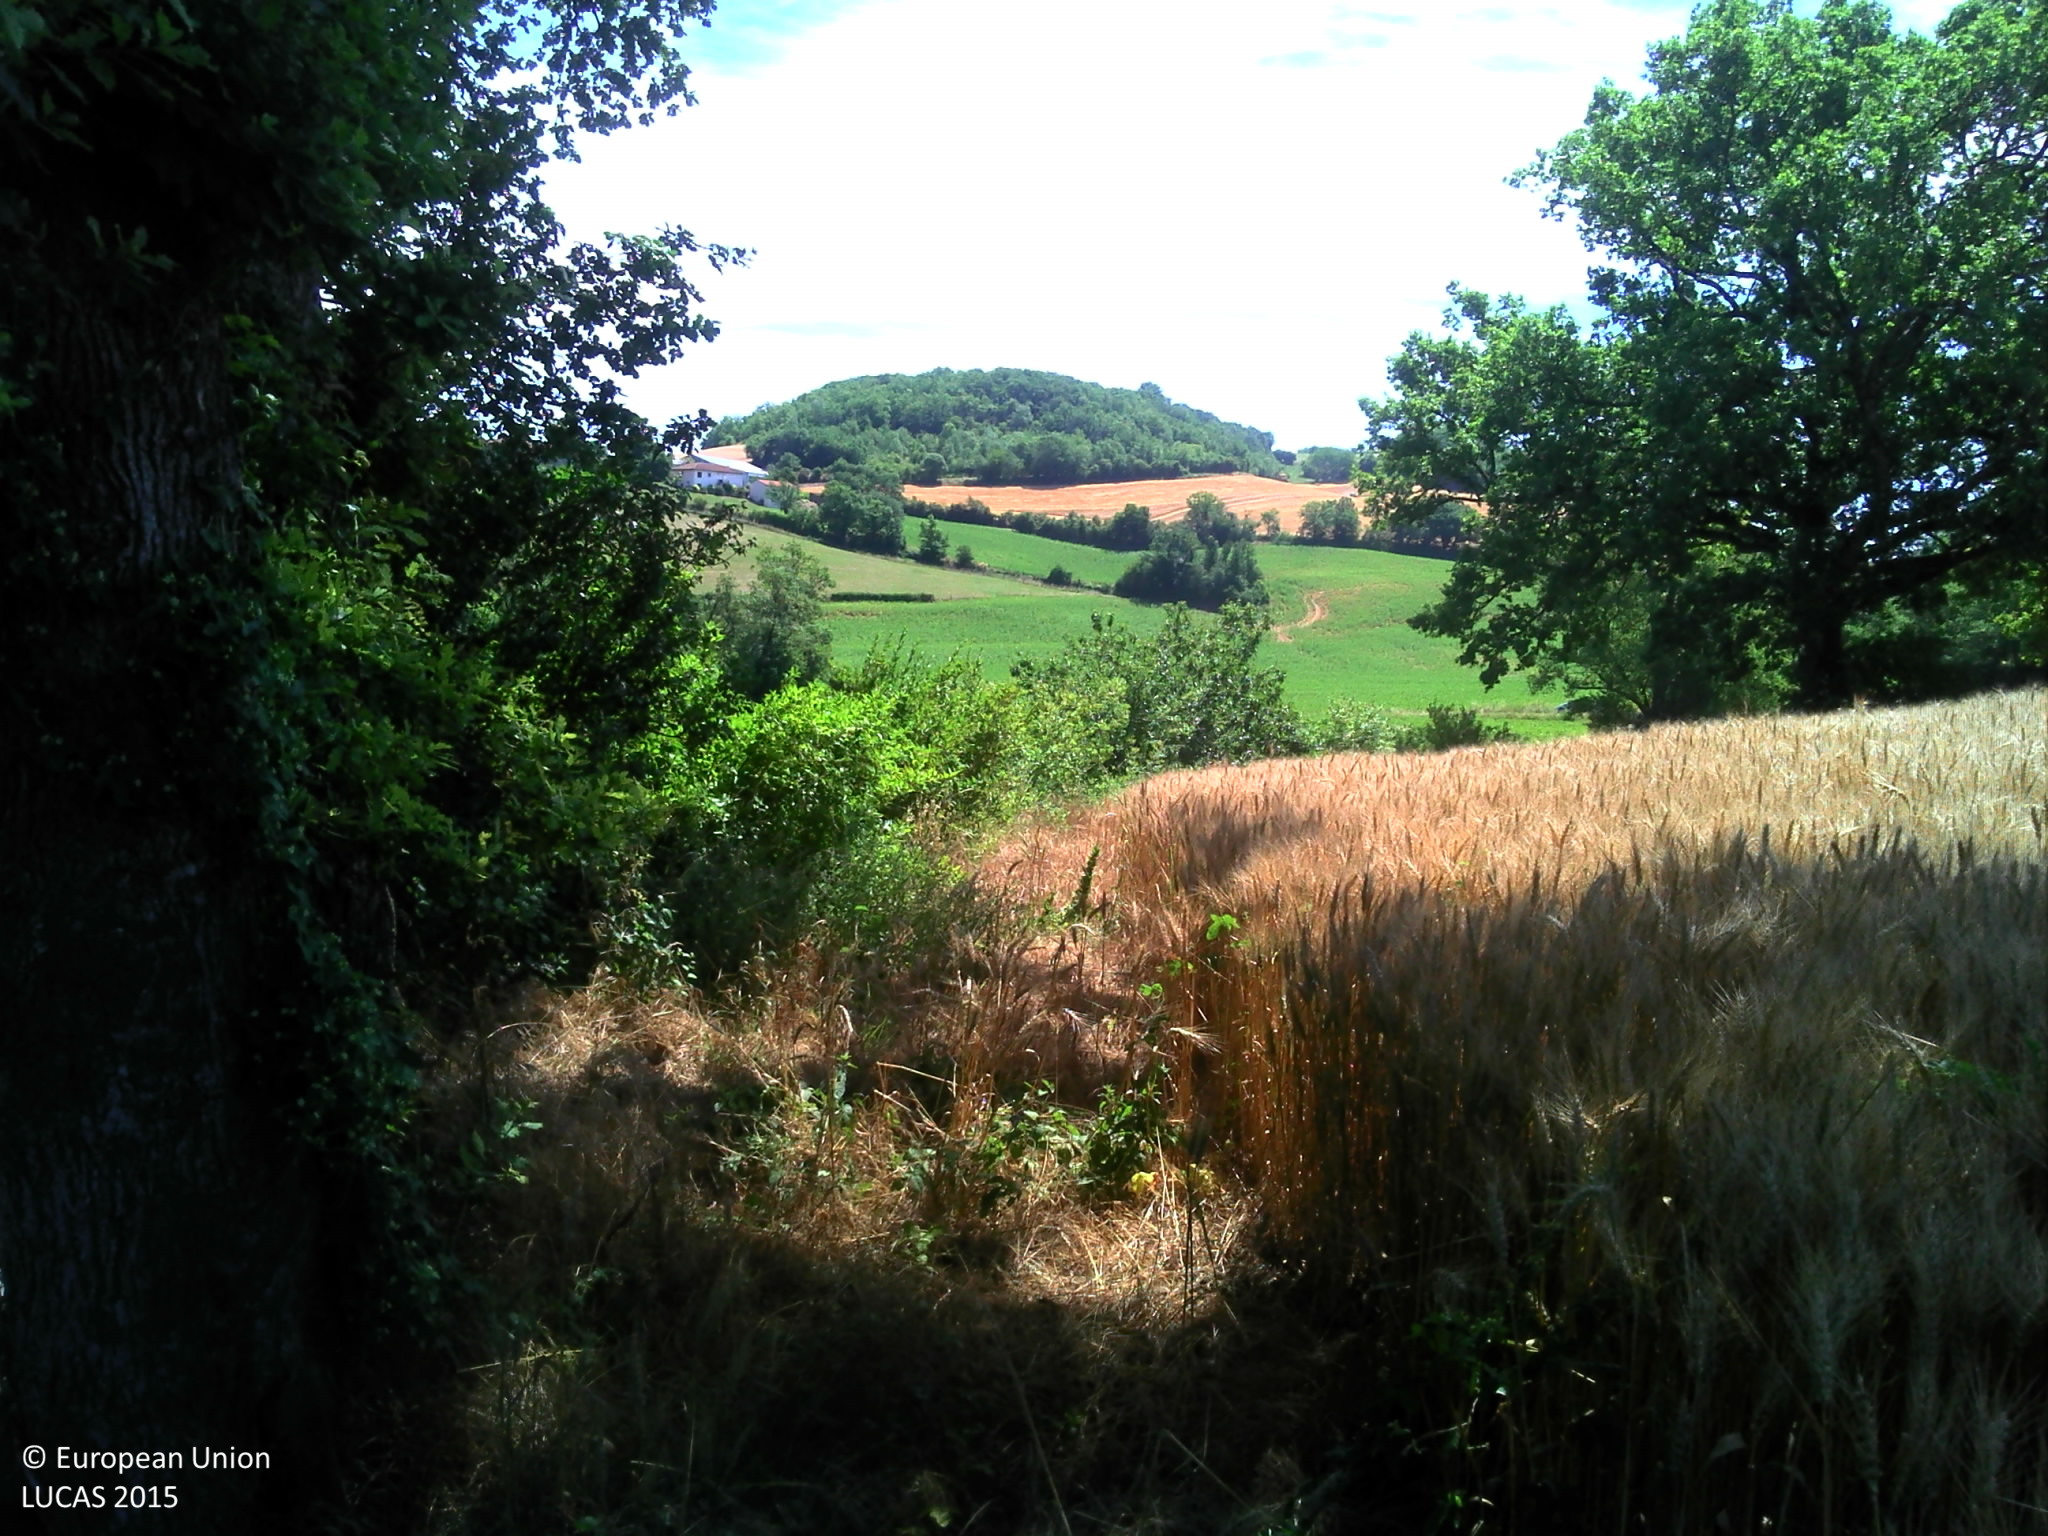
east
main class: Grassland
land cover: Grassland with sparse tree/shrub cover
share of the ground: > 75 %
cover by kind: herbaceous plants 95 %, coniferous forest trees 5 %
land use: Semi-natural and natural areas not in use
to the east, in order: Grassland with sparse tree/shrub cover; Paved roads, cycling and walking lanes; Grass margins; Sunflower; Grass margins; Rivers and streams; Grass margins; Sunflower; Grass margins; Rivers and streams; Lines of trees; Grass margins; Paved roads, cycling and walking lanes; Grass margins; Ditches and canals; Grass margins; Sunflower
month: June
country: FR
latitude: 44.0474
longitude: 2.0777
